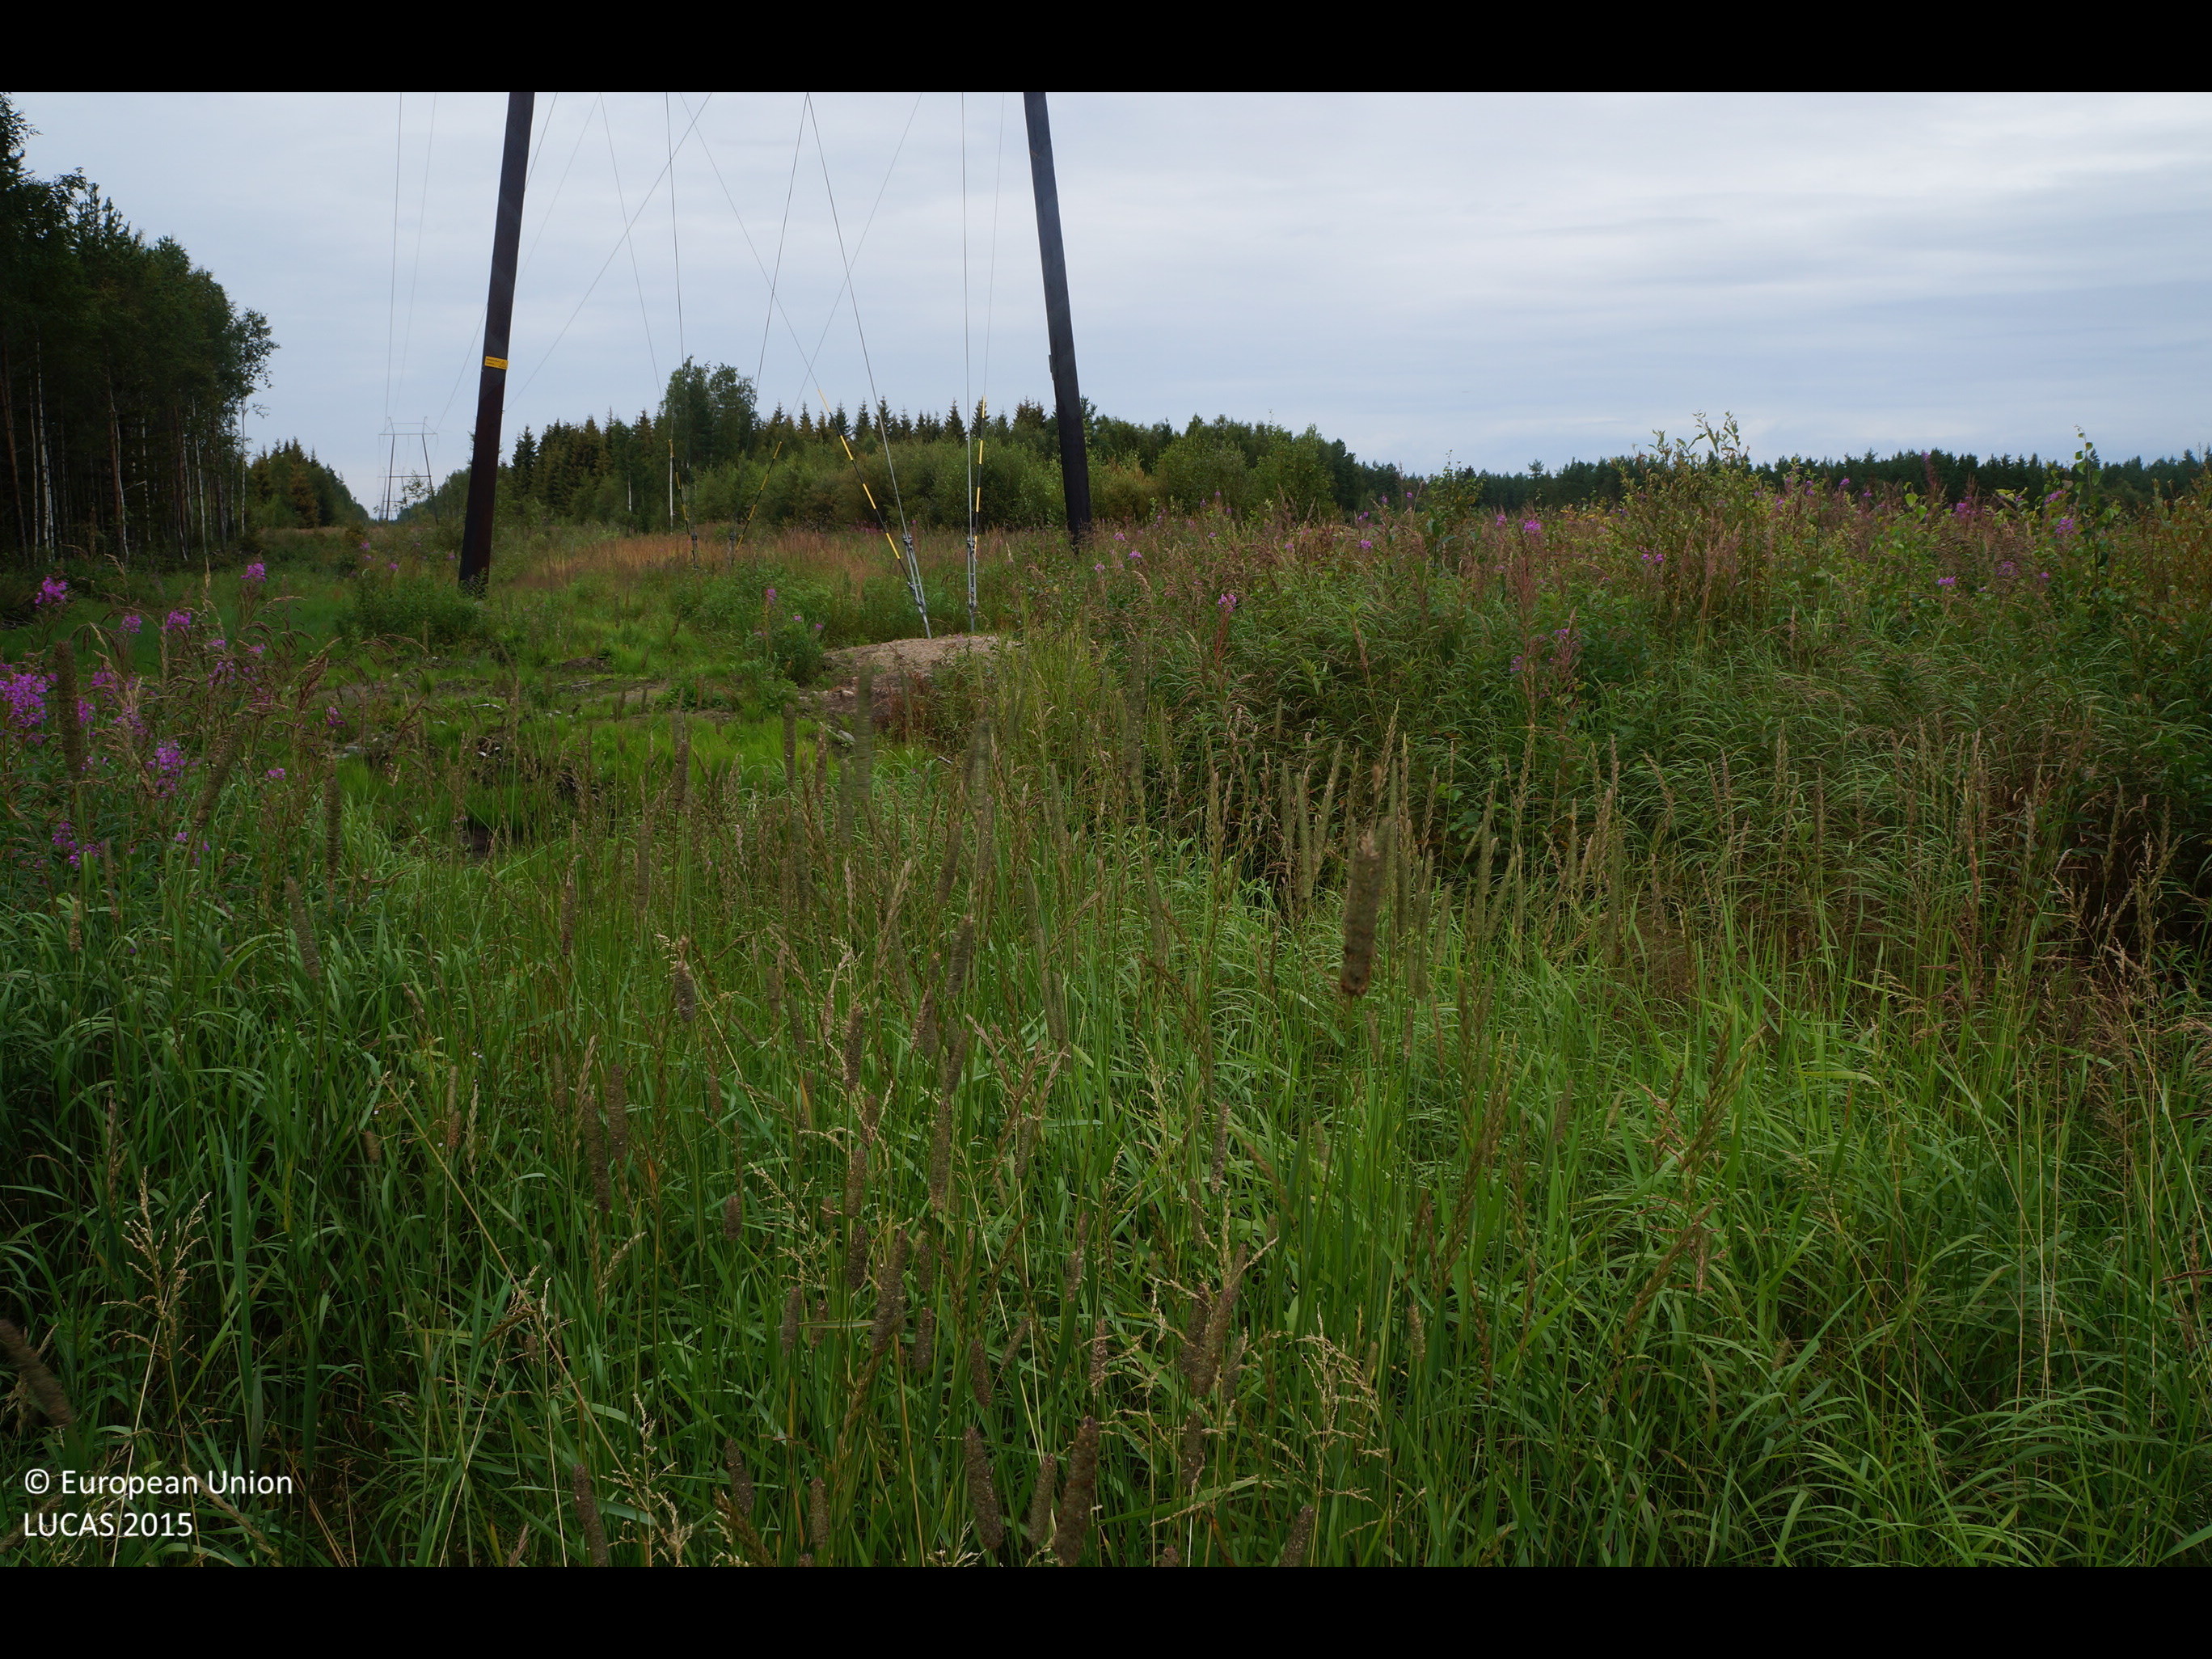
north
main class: Grassland
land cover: Grassland without tree/shrub cover
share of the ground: > 75 %
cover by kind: herbaceous plants 95 %, shrubs 5 %
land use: Electricity, gas and thermal power distribution
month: August
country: FI
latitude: 64.7528
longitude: 24.9736
